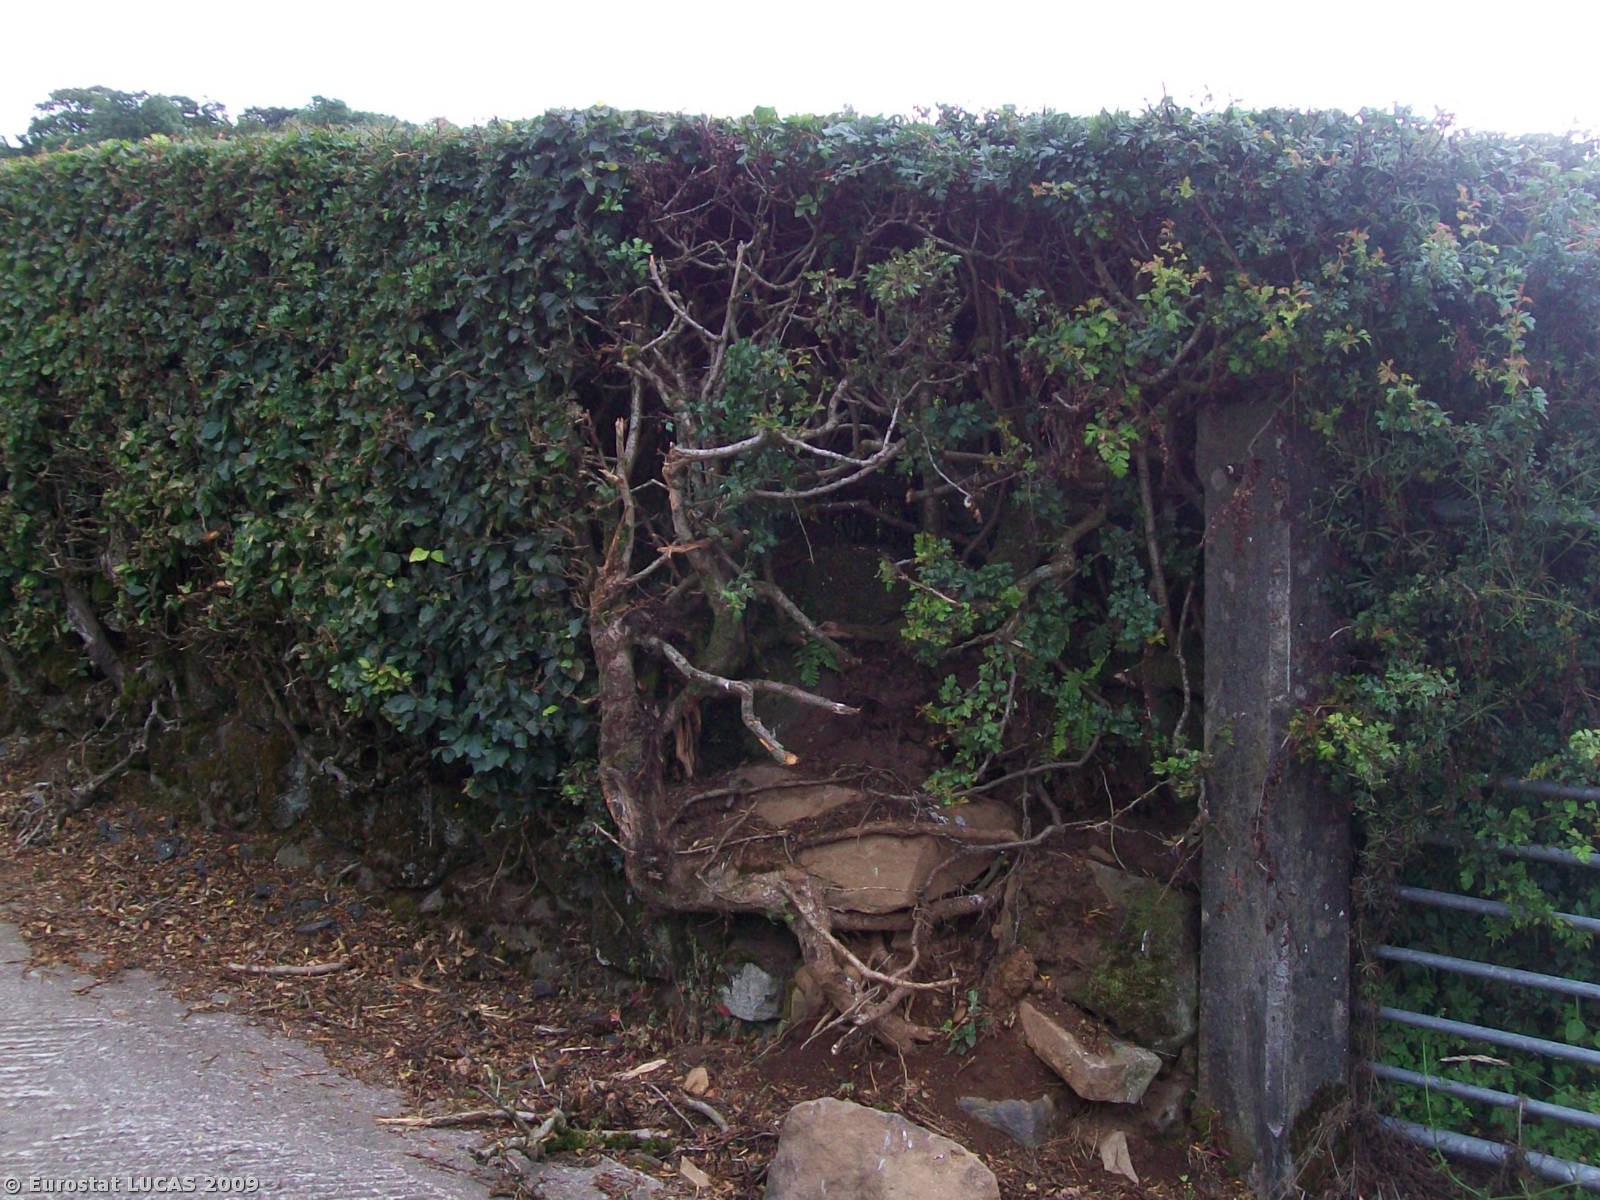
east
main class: Grassland
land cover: Grassland without tree/shrub cover
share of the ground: > 75 %
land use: Agriculture (excluding fallow land and kitchen gardens)
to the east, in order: Grassland without tree/shrub cover; Fences; Grass margins; Dry stone walls; Paved roads, cycling and walking lanes; Dry stone walls; Managed hedges; Grassland without tree/shrub cover; Electric lines; Grassland without tree/shrub cover; Electric lines; Grassland without tree/shrub cover; Dry stone walls; Abandoned hedges; Broadleaved woodland
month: July
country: GB
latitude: 54.9230
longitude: -6.2331
